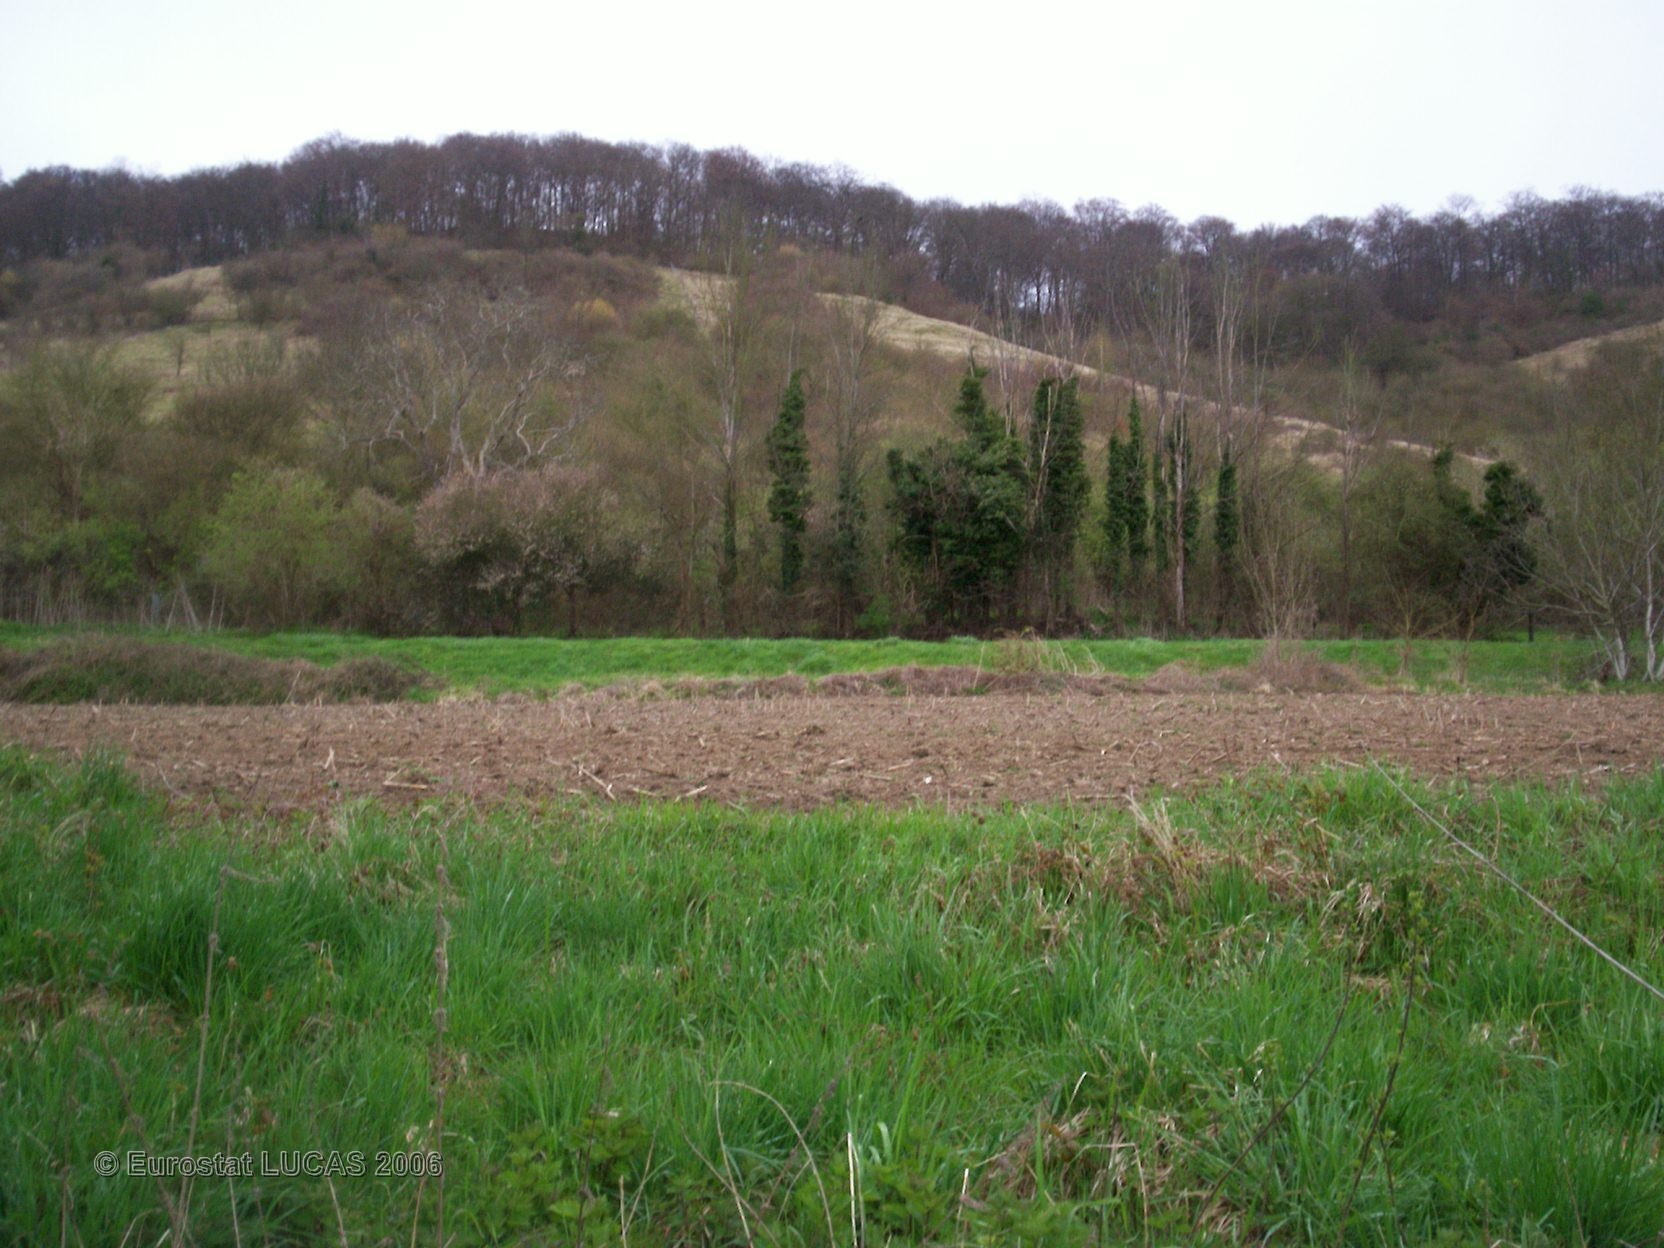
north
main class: Grassland
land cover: Grassland without tree/shrub cover
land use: Agriculture (excluding fallow land and kitchen gardens)
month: April
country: FR
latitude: 49.4788
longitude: 0.9369
